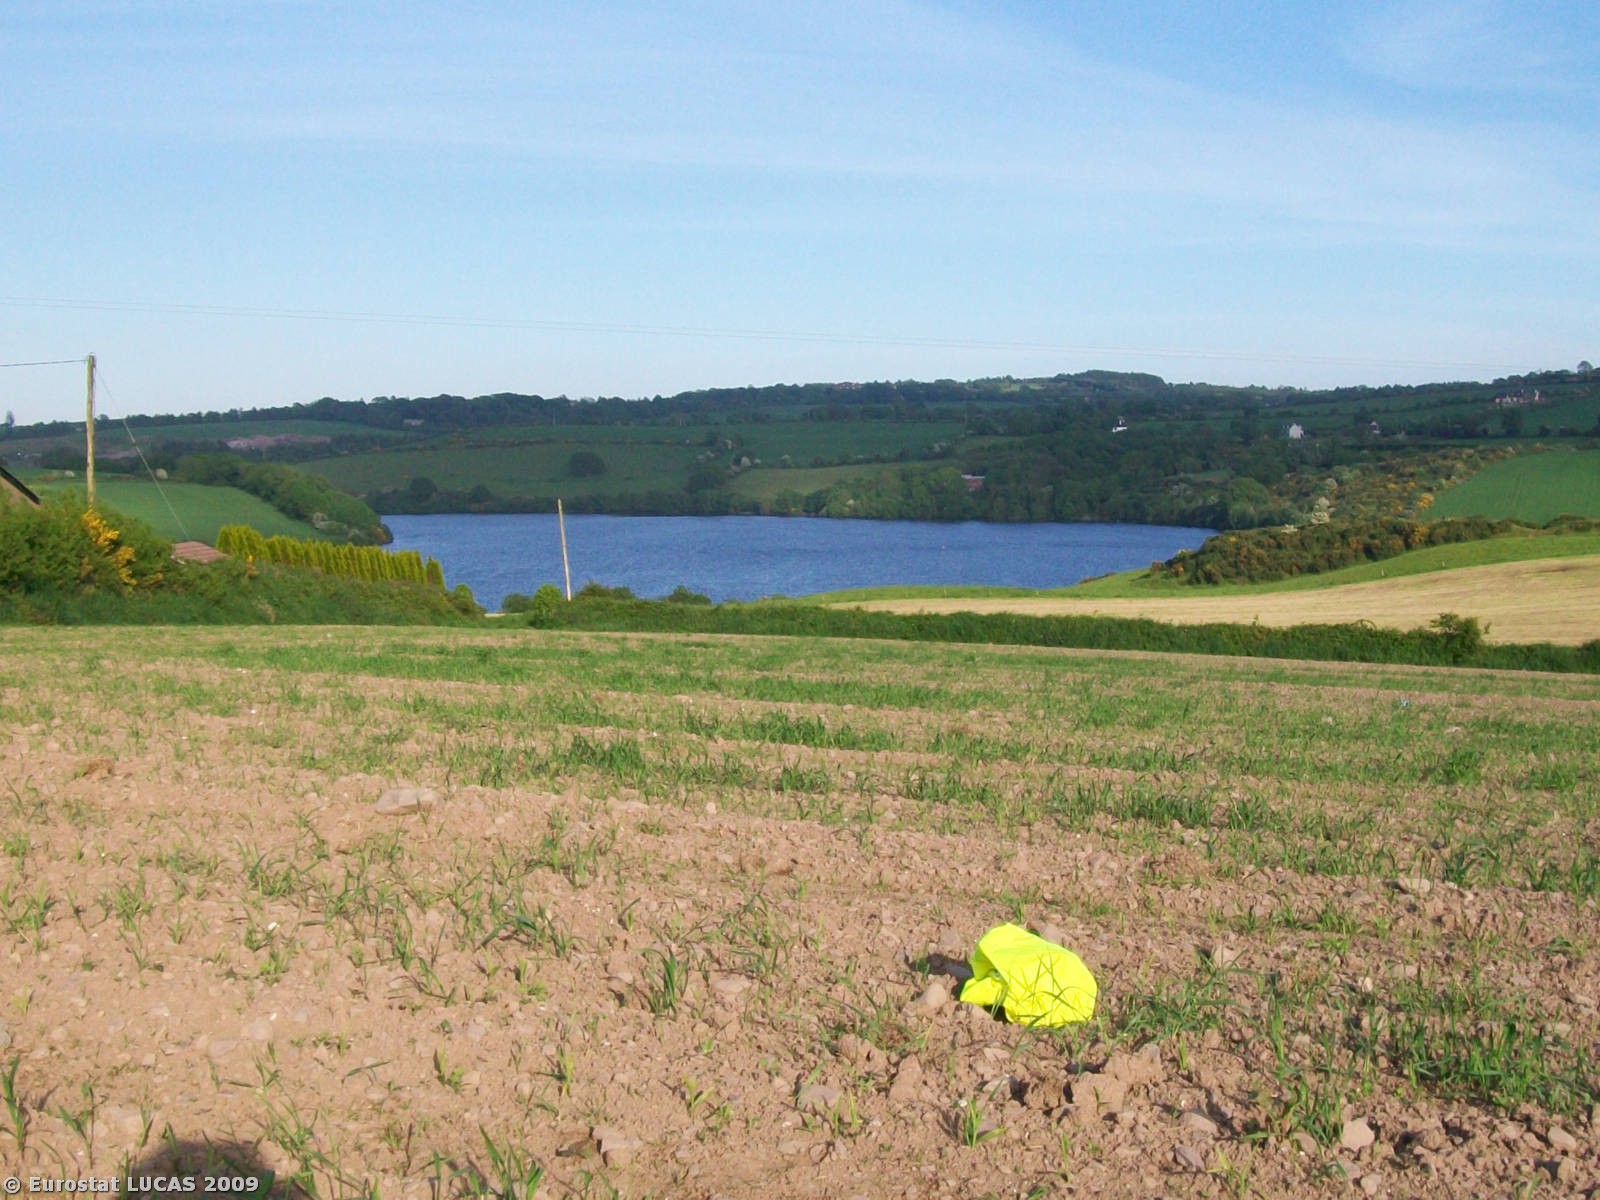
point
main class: Cropland
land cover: Common wheat
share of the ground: > 75 %
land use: Agriculture (excluding fallow land and kitchen gardens)
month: May
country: IE
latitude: 51.9012
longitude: -8.7333
